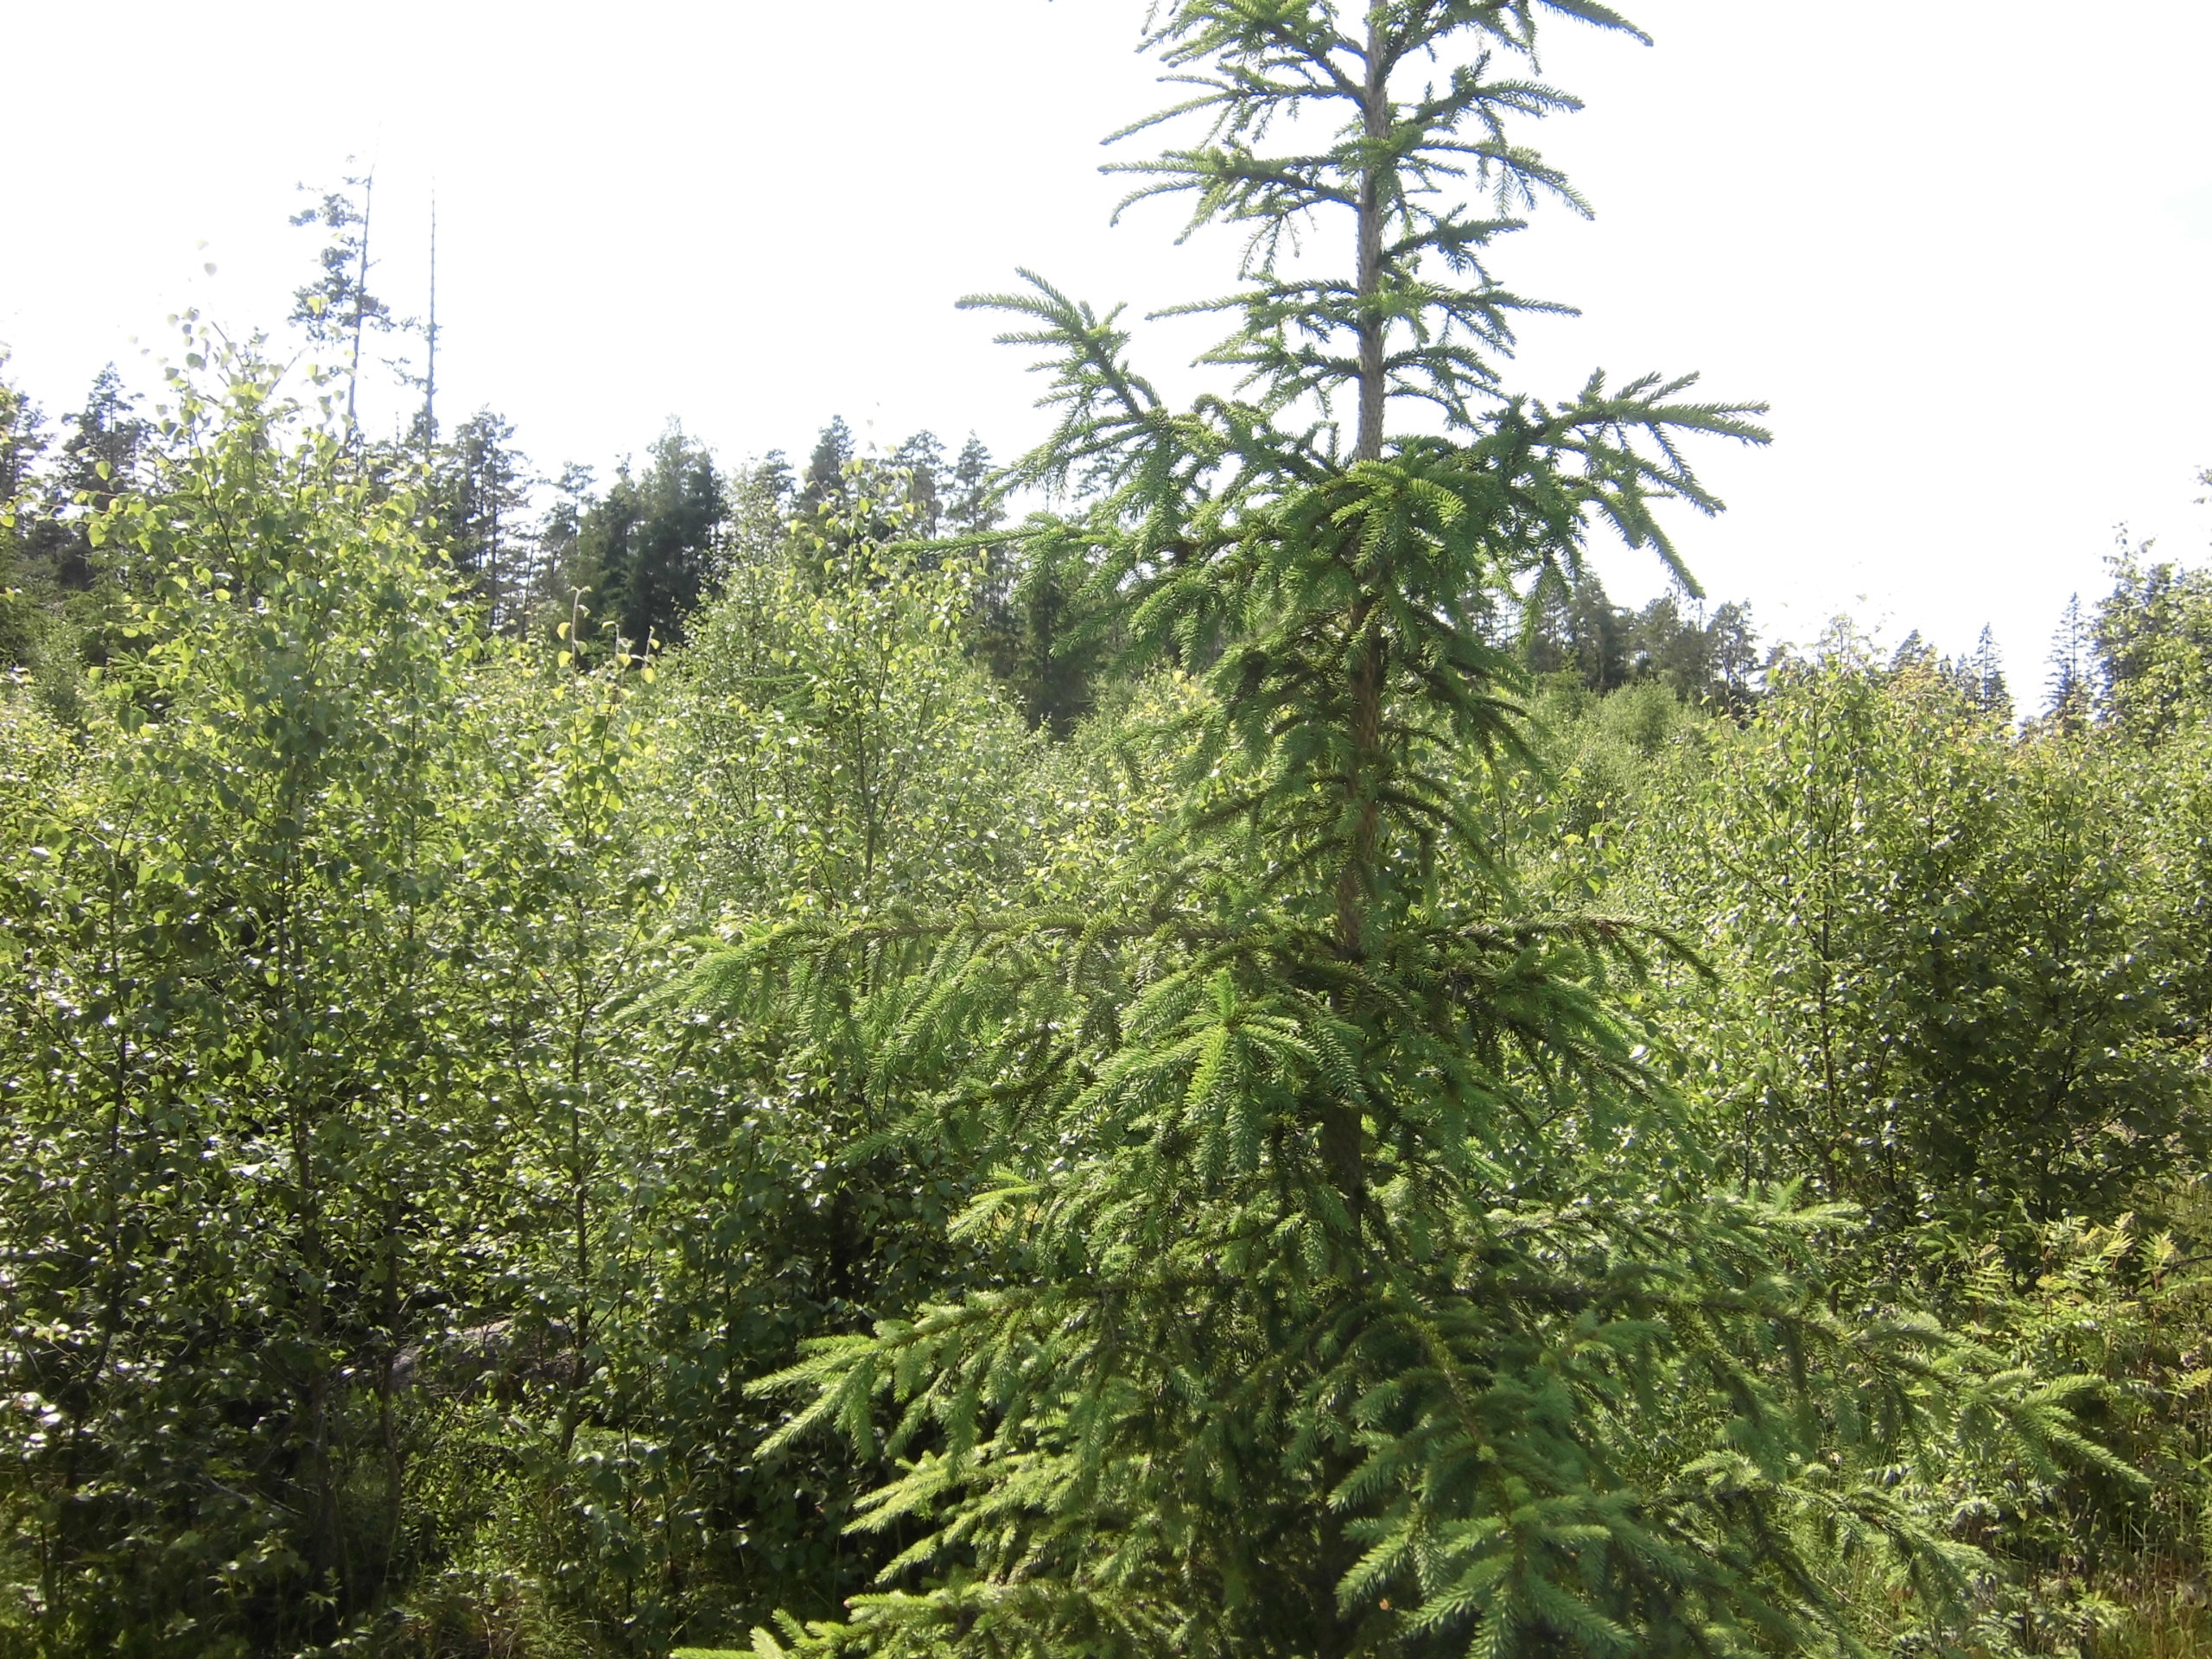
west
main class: Woodland
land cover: Spruce dominated mixed woodland
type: boreal forest
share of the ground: > 75 %
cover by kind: broadleaved forest trees 45 %, coniferous forest trees 30 %, herbaceous plants 15 %, shrubs 5 %, lichens and mosses 5 %
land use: Forestry
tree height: < 5 m
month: July
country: SE
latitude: 57.3493
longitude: 14.5662
